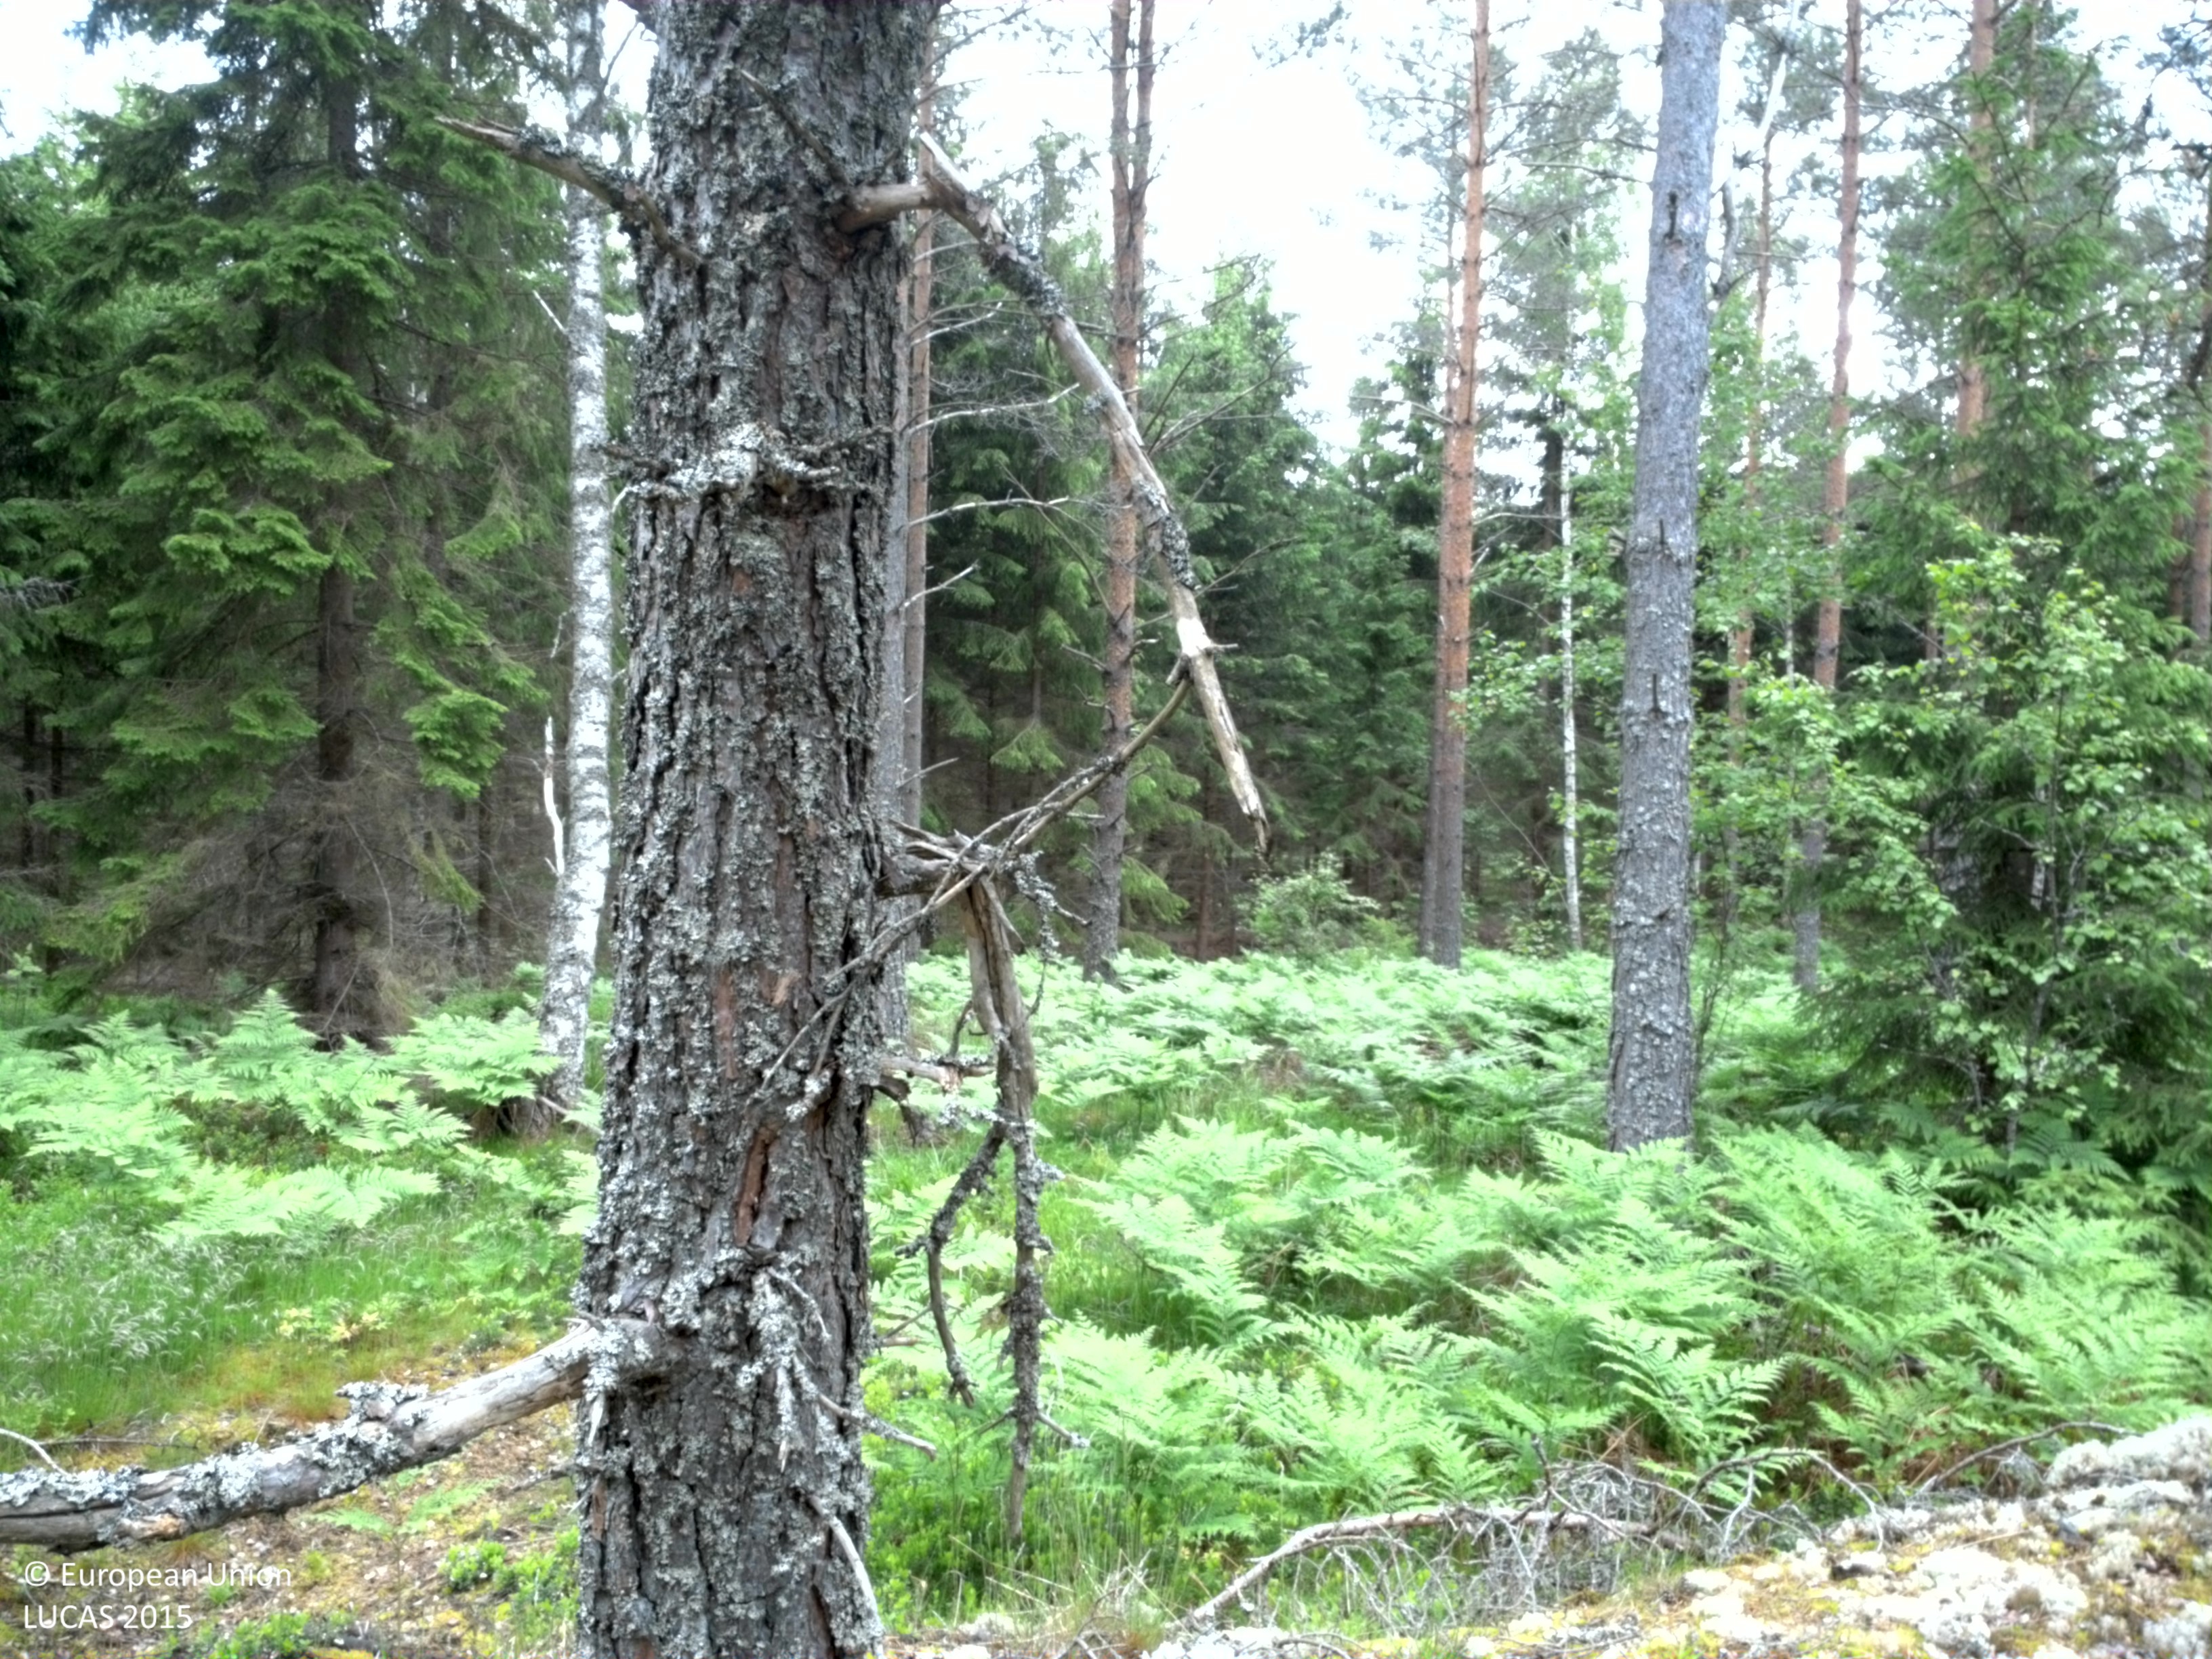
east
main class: Woodland
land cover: Pine dominated coniferous woodland
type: boreal forest
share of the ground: 10 - 25 %
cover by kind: herbaceous plants 25 %, lichens and mosses 25 %, consolidated bare surface 25 %, coniferous forest trees 20 %, broadleaved forest trees 5 %
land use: Forestry
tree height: > 5 m
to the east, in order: Pine dominated coniferous woodland; Spruce dominated coniferous woodland; Ditches and canals; Spruce dominated coniferous woodland; Grassland without tree/shrub cover; Ditches and canals; Electric lines; Spruce dominated mixed woodland; Spruce dominated coniferous woodland; Spruce dominated mixed woodland
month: June
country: SE
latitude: 59.6993
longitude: 18.6178
